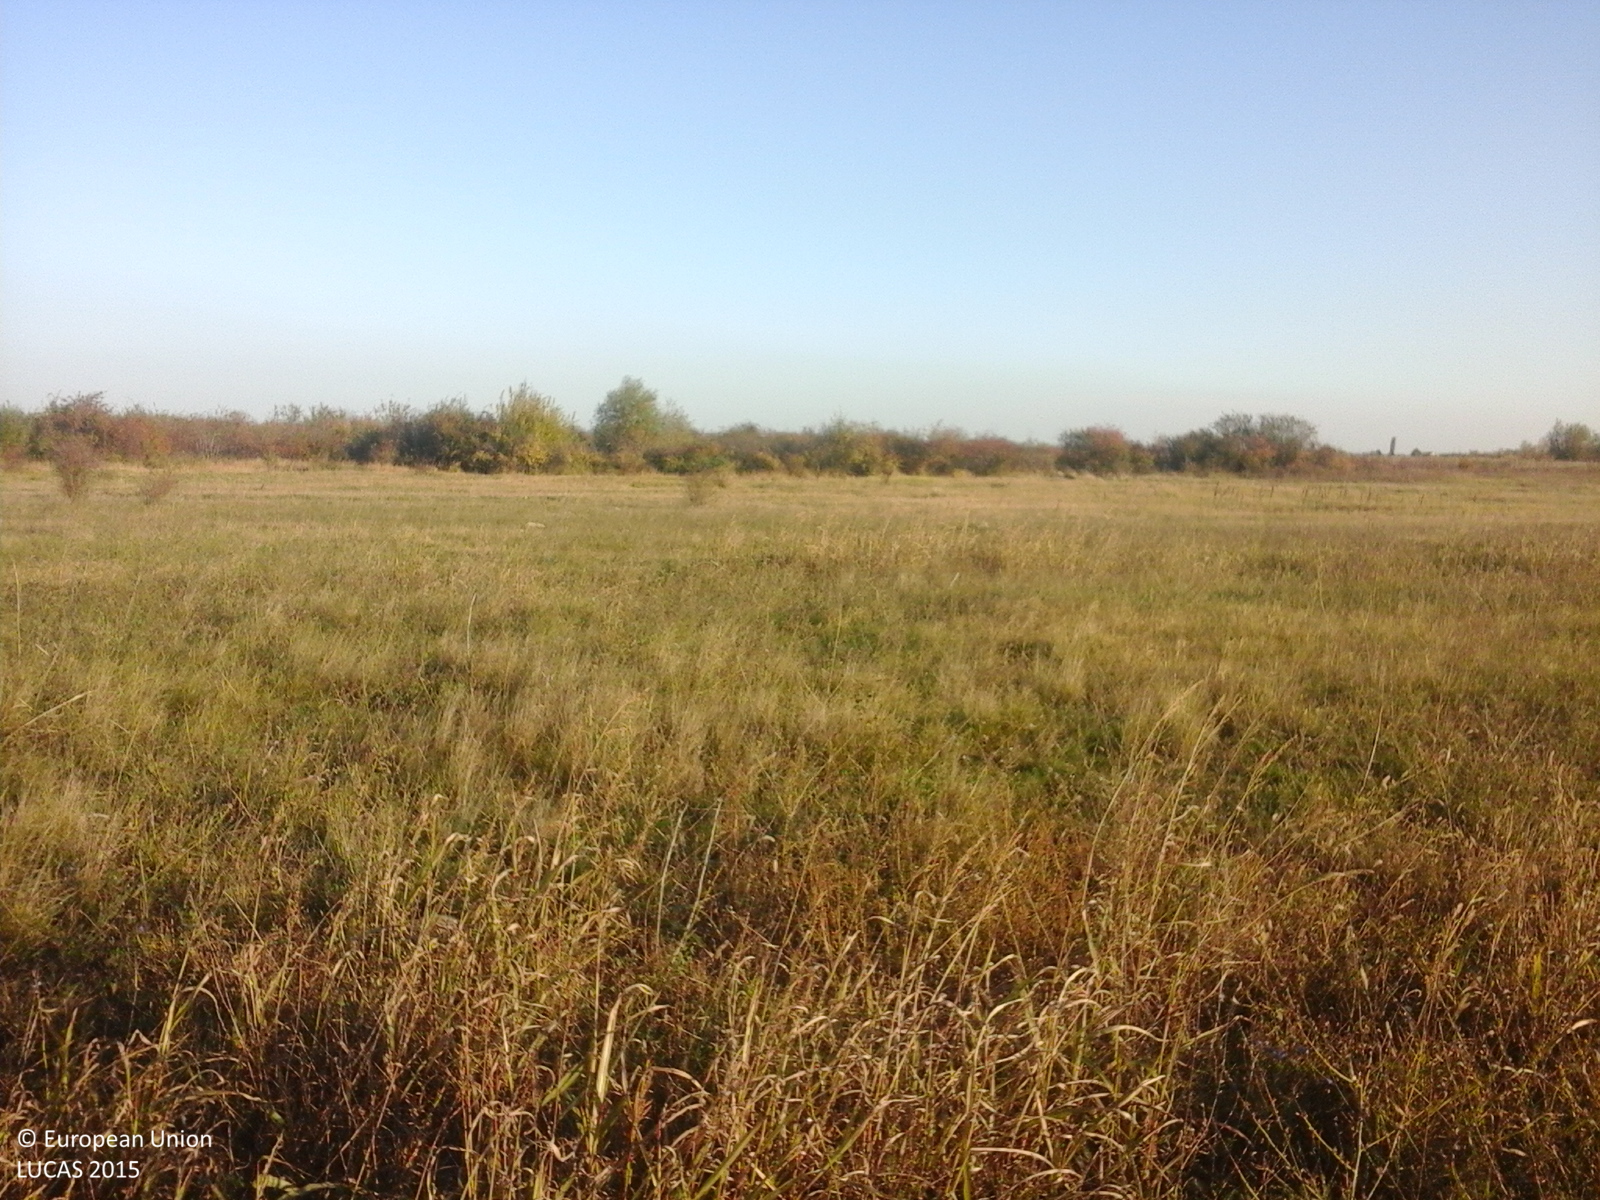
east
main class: Grassland
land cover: Spontaneously vegetated surfaces
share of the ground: > 75 %
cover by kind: herbaceous plants 100 %
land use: Fallow land
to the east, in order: Spontaneously vegetated surfaces; Tracks; Grassland without tree/shrub cover; Shrubland without tree cover; Inland marshes; Ditches and canals; Inland marshes; Shrubland without tree cover; Grassland without tree/shrub cover; Tracks; Grassland without tree/shrub cover; Ditches and canals
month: October
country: RO
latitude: 45.8219
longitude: 27.1227
